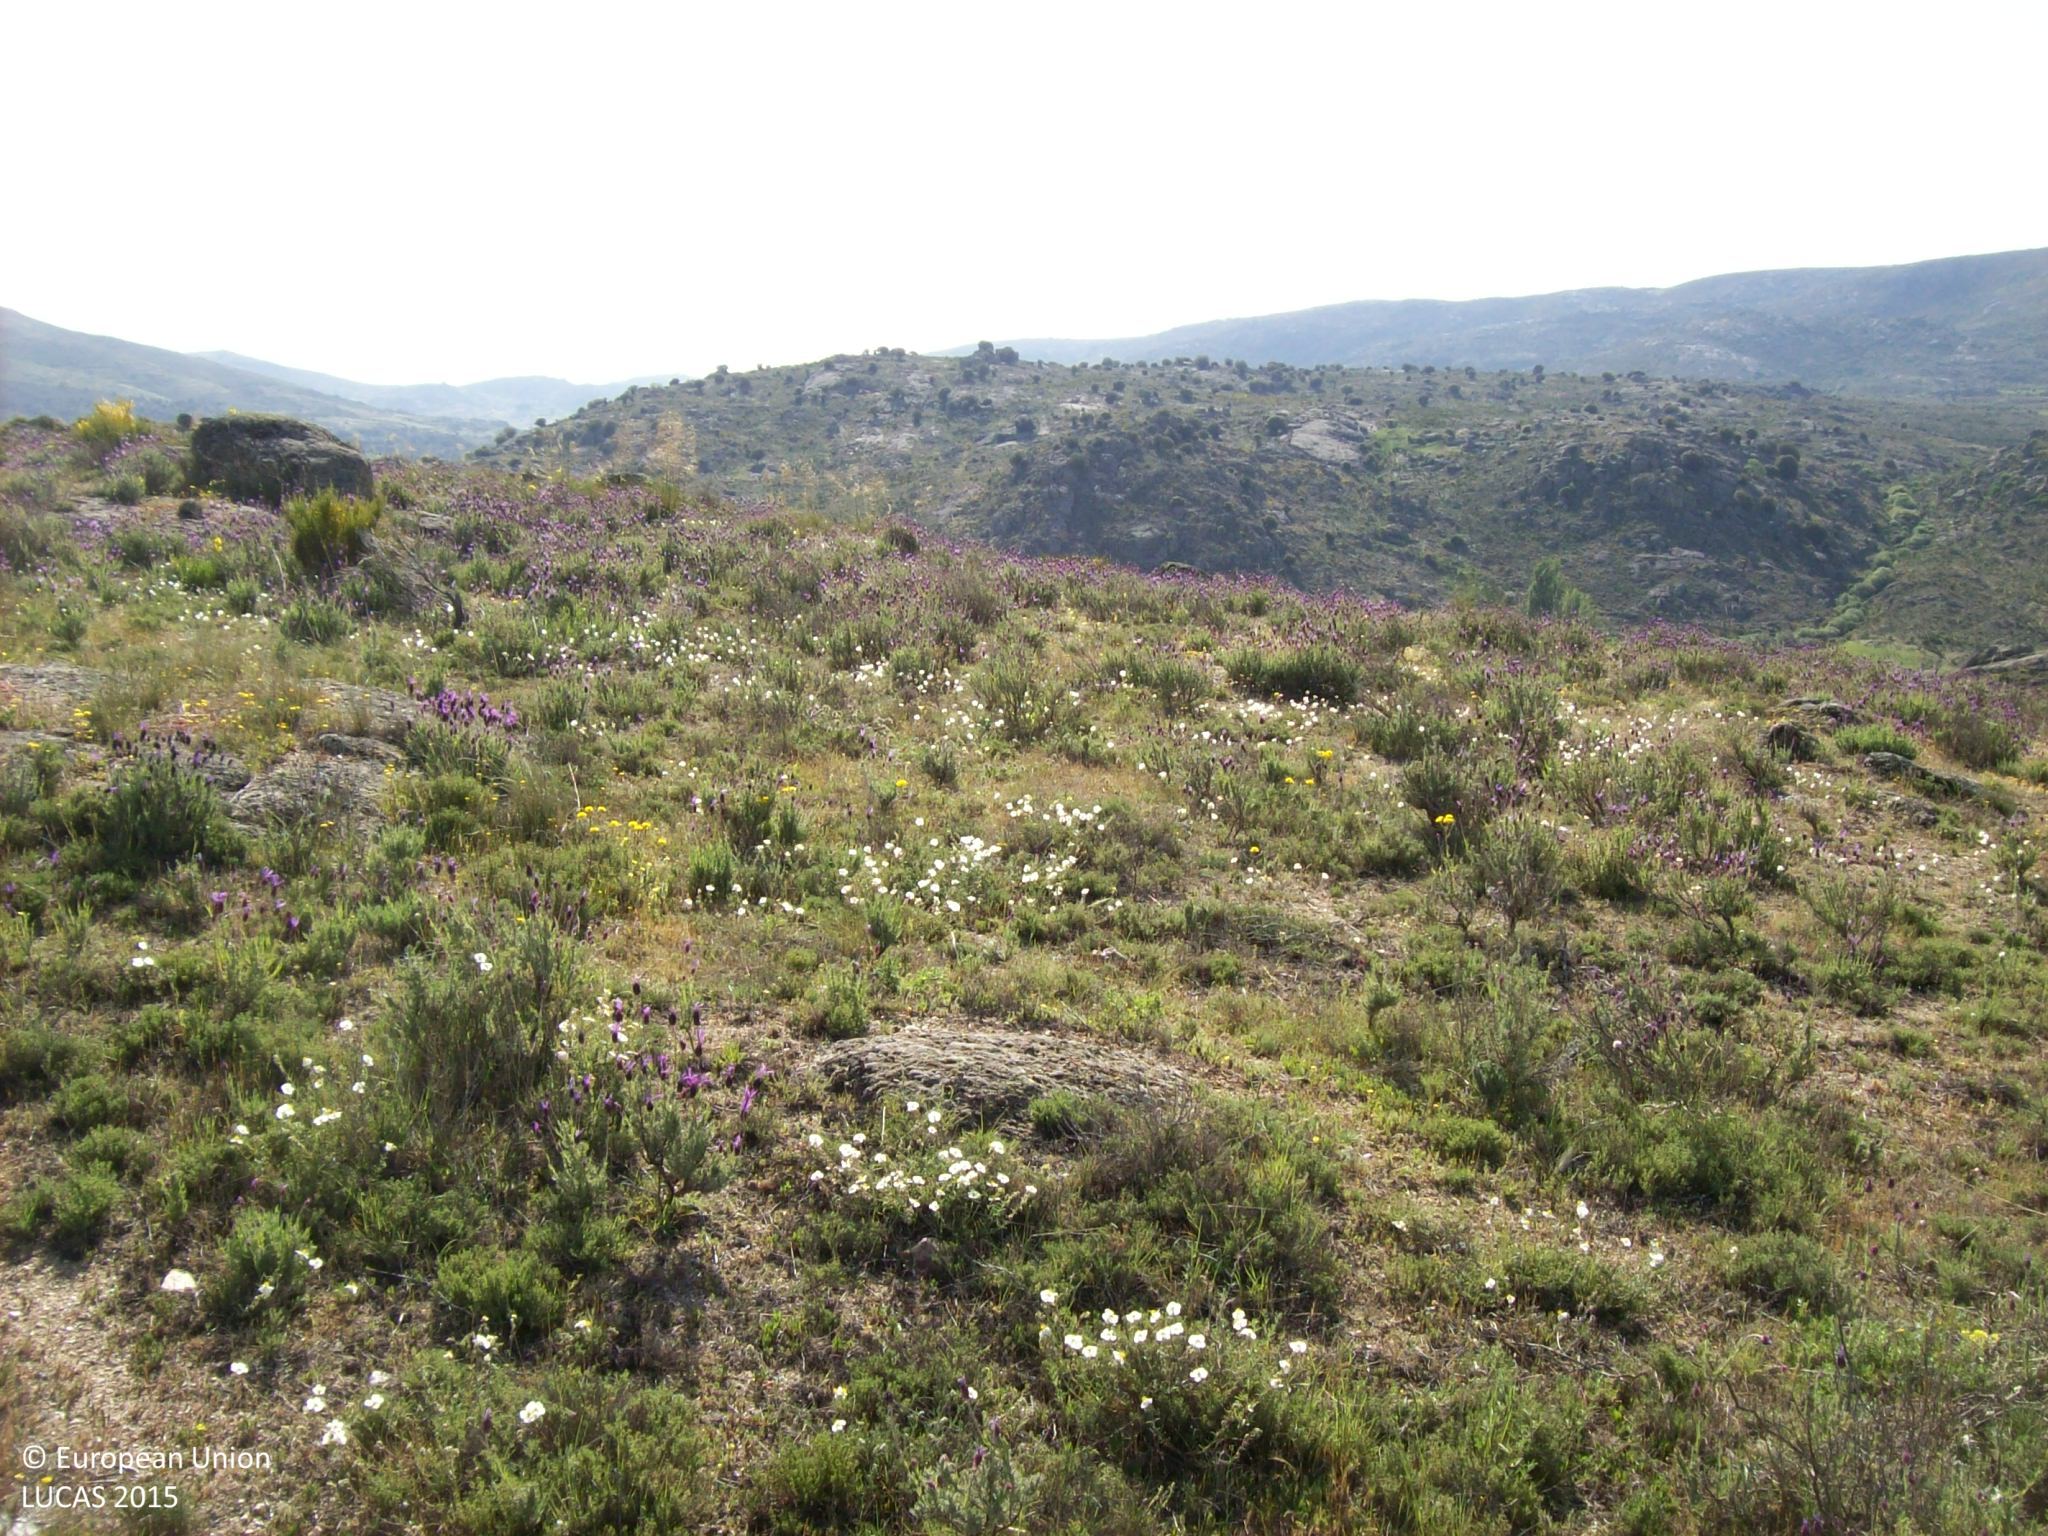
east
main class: Shrubland
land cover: Shrubland without tree cover
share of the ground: 50 - 75 %
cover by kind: shrubs 60 %, herbaceous plants 20 %, consolidated bare surface 5 %, unconsolidated bare surface 5 %
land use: Semi-natural and natural areas not in use
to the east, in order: Shrubland without tree cover; Rock outcrops; Shrubland with sparse tree cover; Rock outcrops; Shrubland without tree cover; Rock outcrops
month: May
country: ES
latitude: 40.5470
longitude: -4.8280
